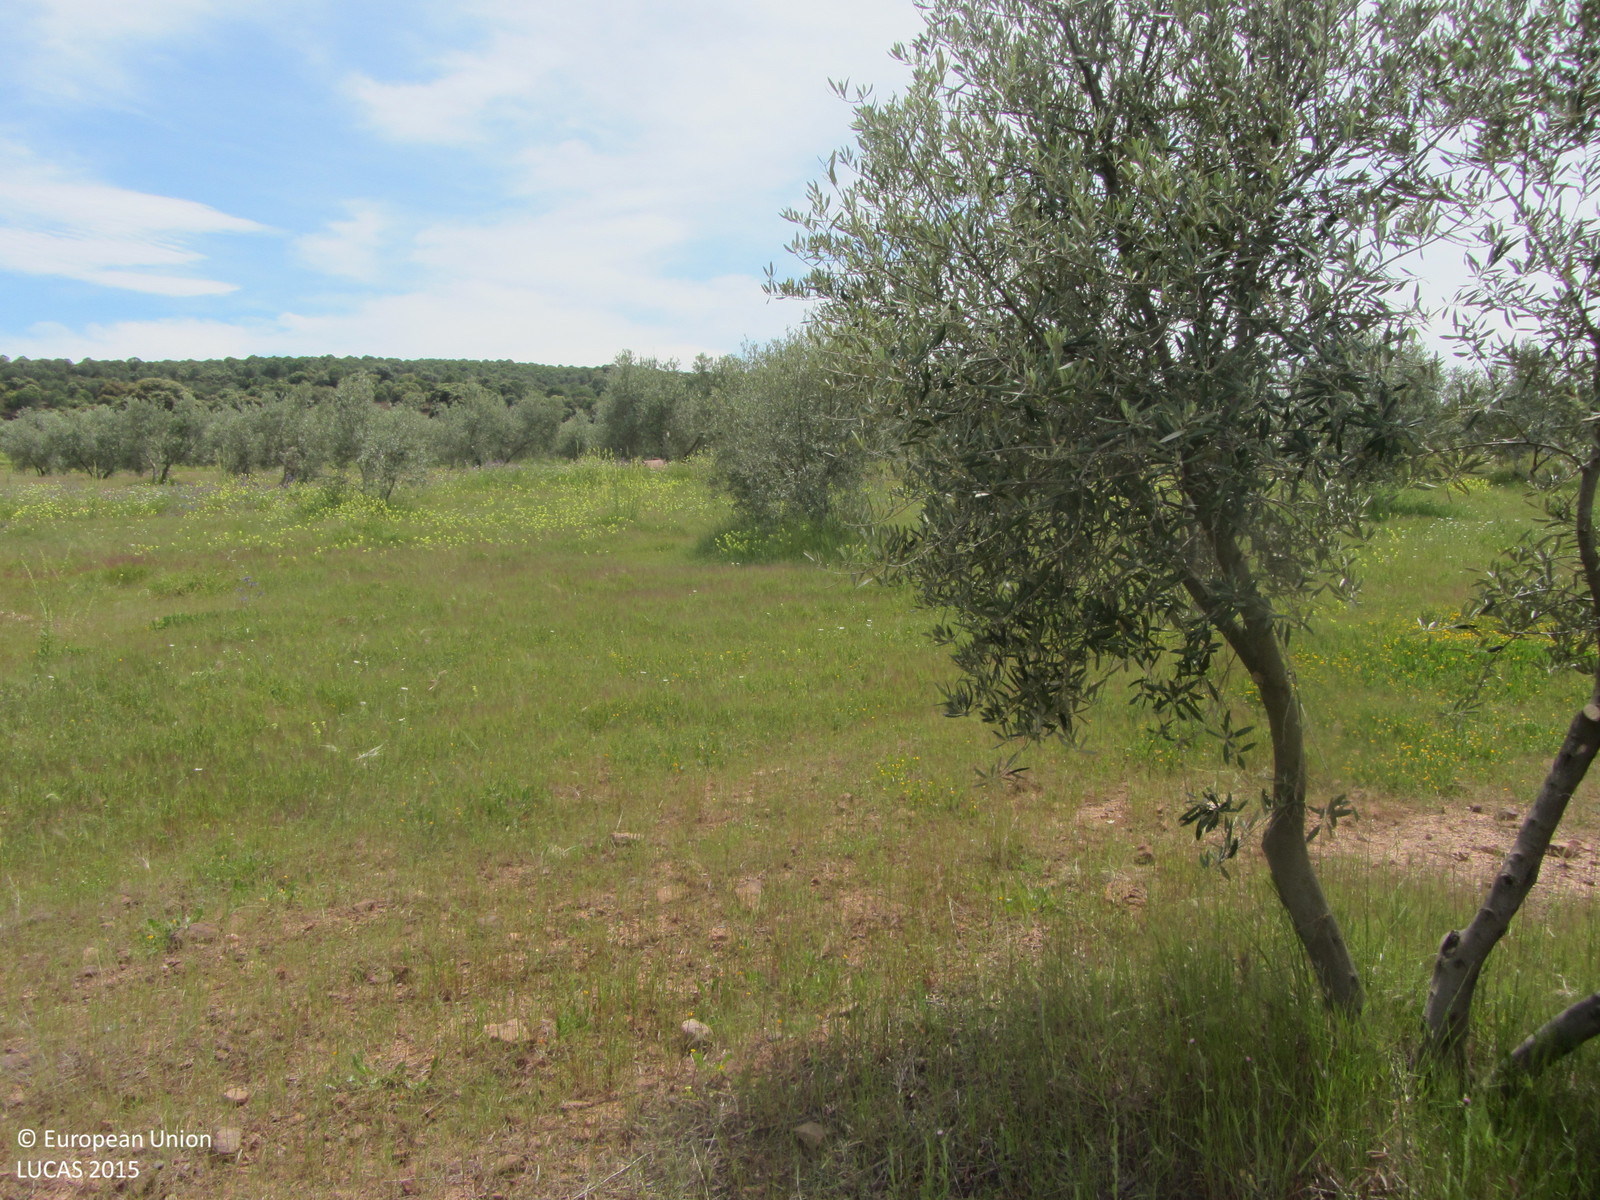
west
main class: Cropland
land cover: Olive groves
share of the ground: 10 - 25 %
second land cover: Spontaneously vegetated surfaces
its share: > 75 %
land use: Agriculture (excluding fallow land and kitchen gardens)
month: May
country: ES
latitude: 38.3559
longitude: -2.9898
